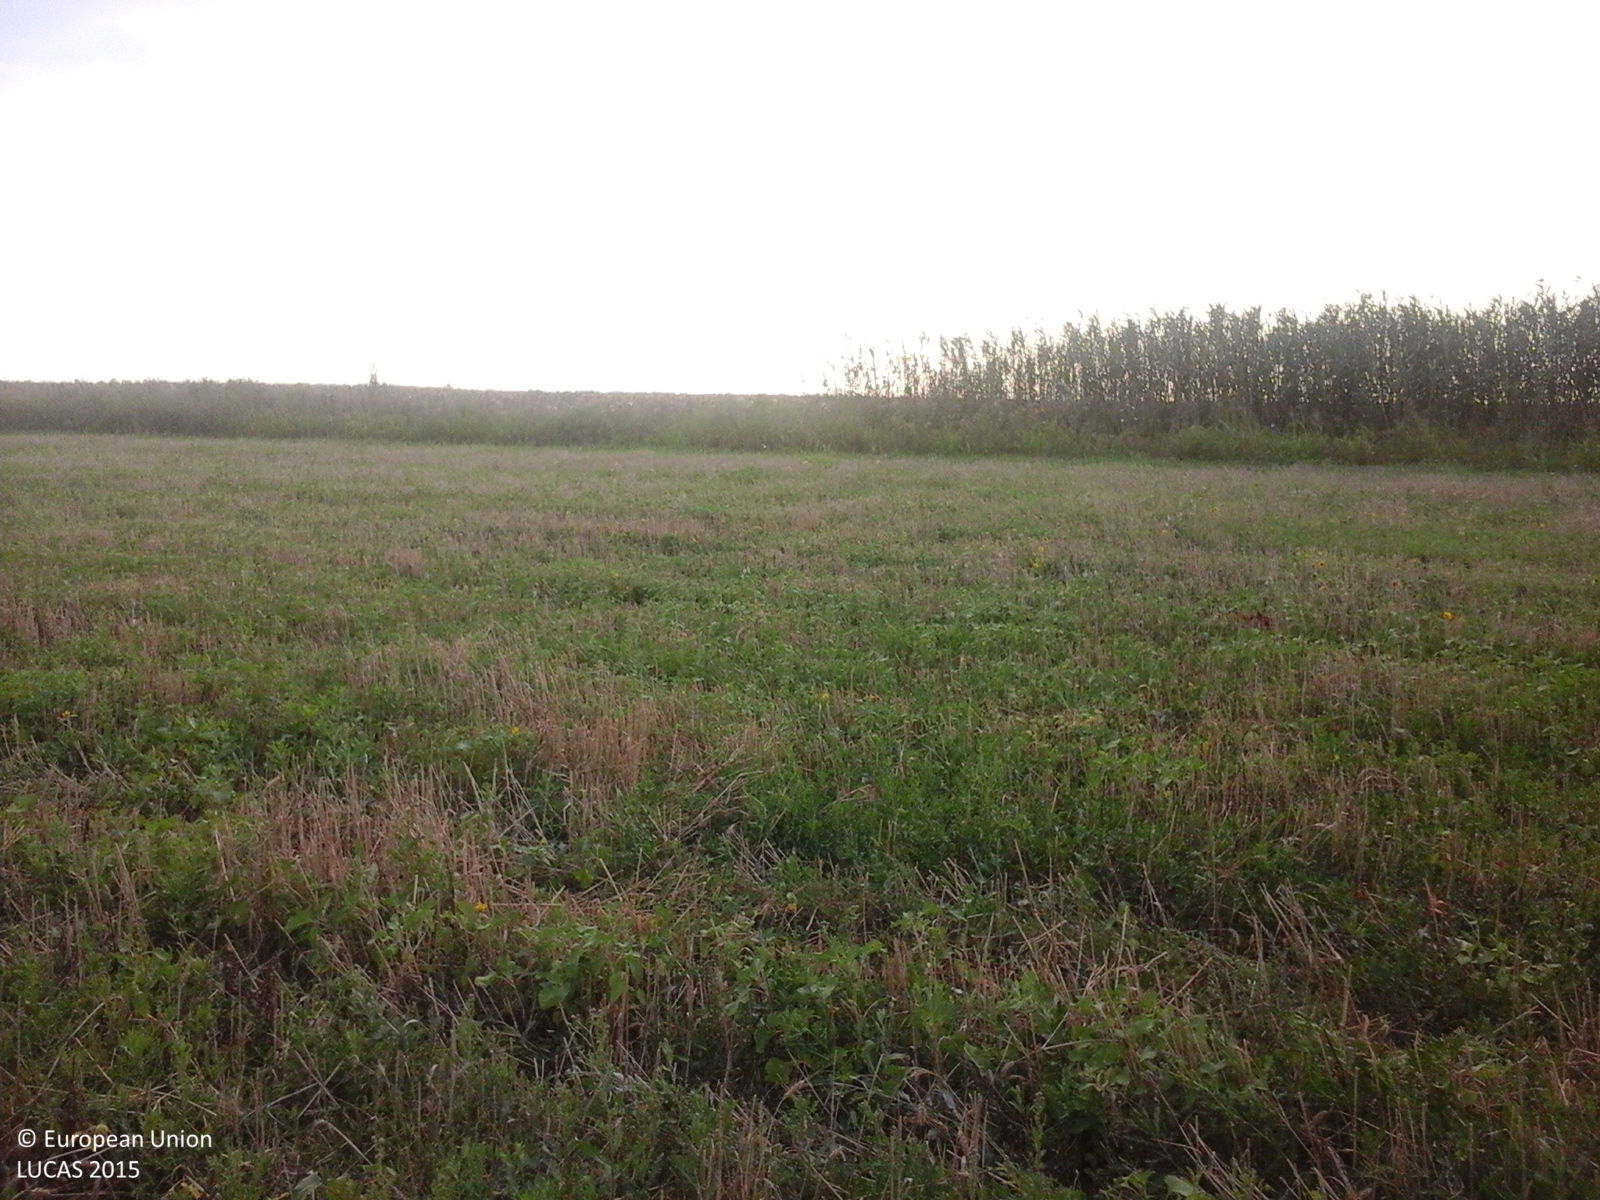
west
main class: Cropland
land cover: Durum wheat
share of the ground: 25 - 50 %
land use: Agriculture (excluding fallow land and kitchen gardens)
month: August
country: RO
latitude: 44.7291
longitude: 28.0279
